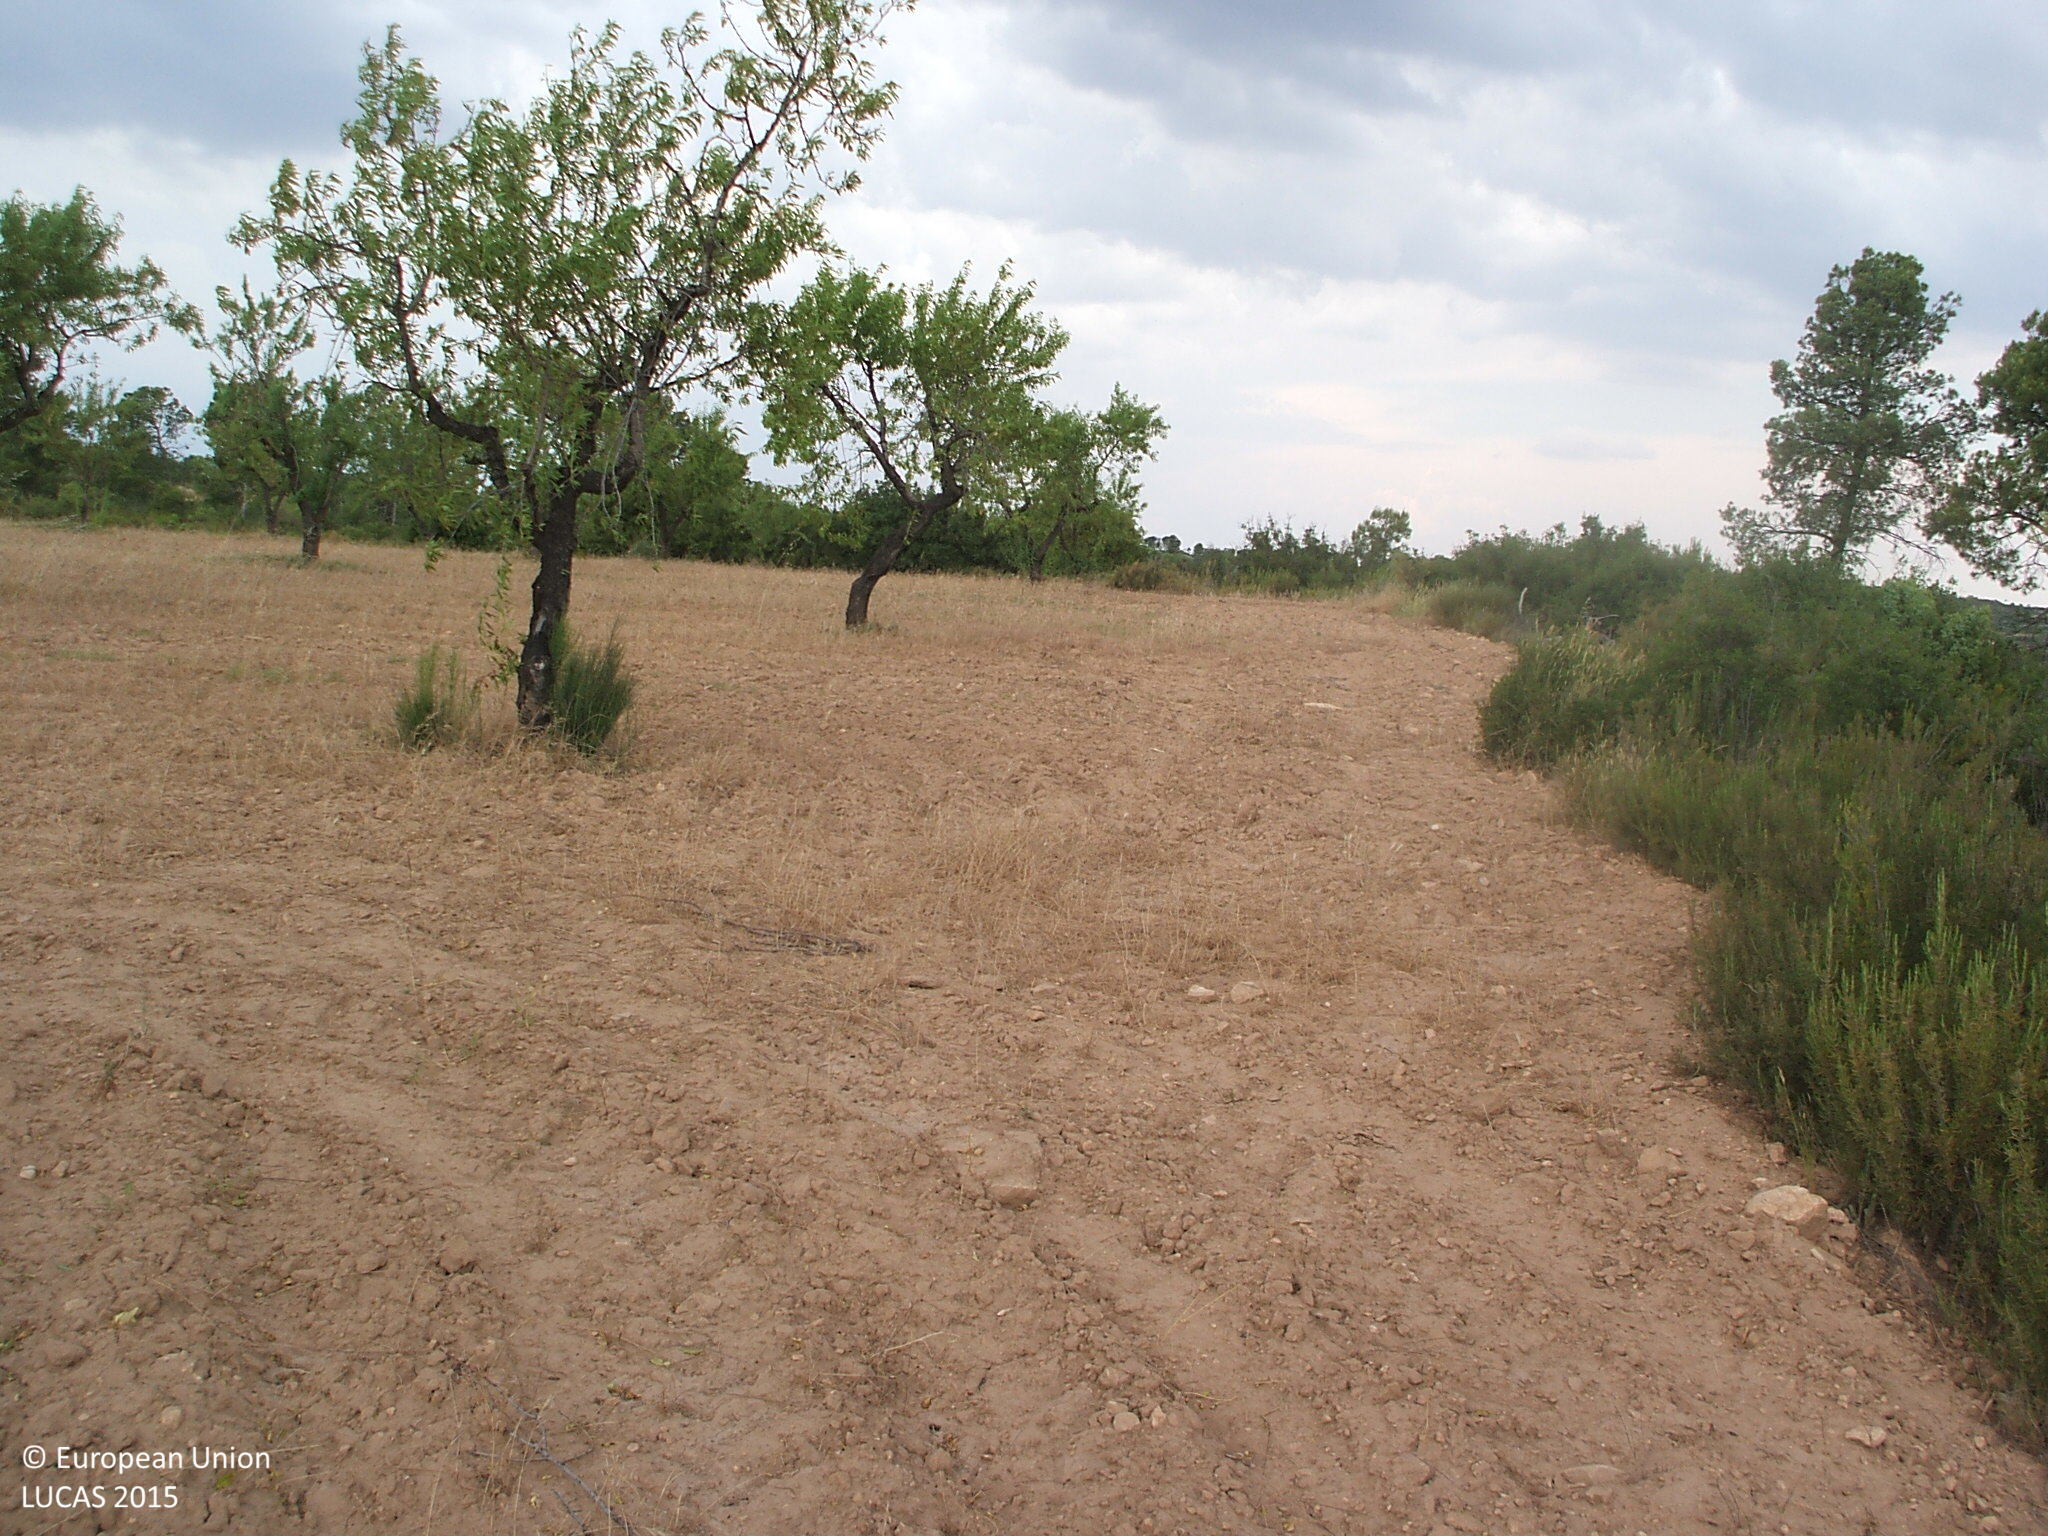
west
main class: Shrubland
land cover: Shrubland with sparse tree cover
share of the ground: > 75 %
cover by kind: shrubs 95 %, coniferous forest trees 5 %
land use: Semi-natural and natural areas not in use
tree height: > 5 m
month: June
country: ES
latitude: 41.0286
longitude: -0.0131
